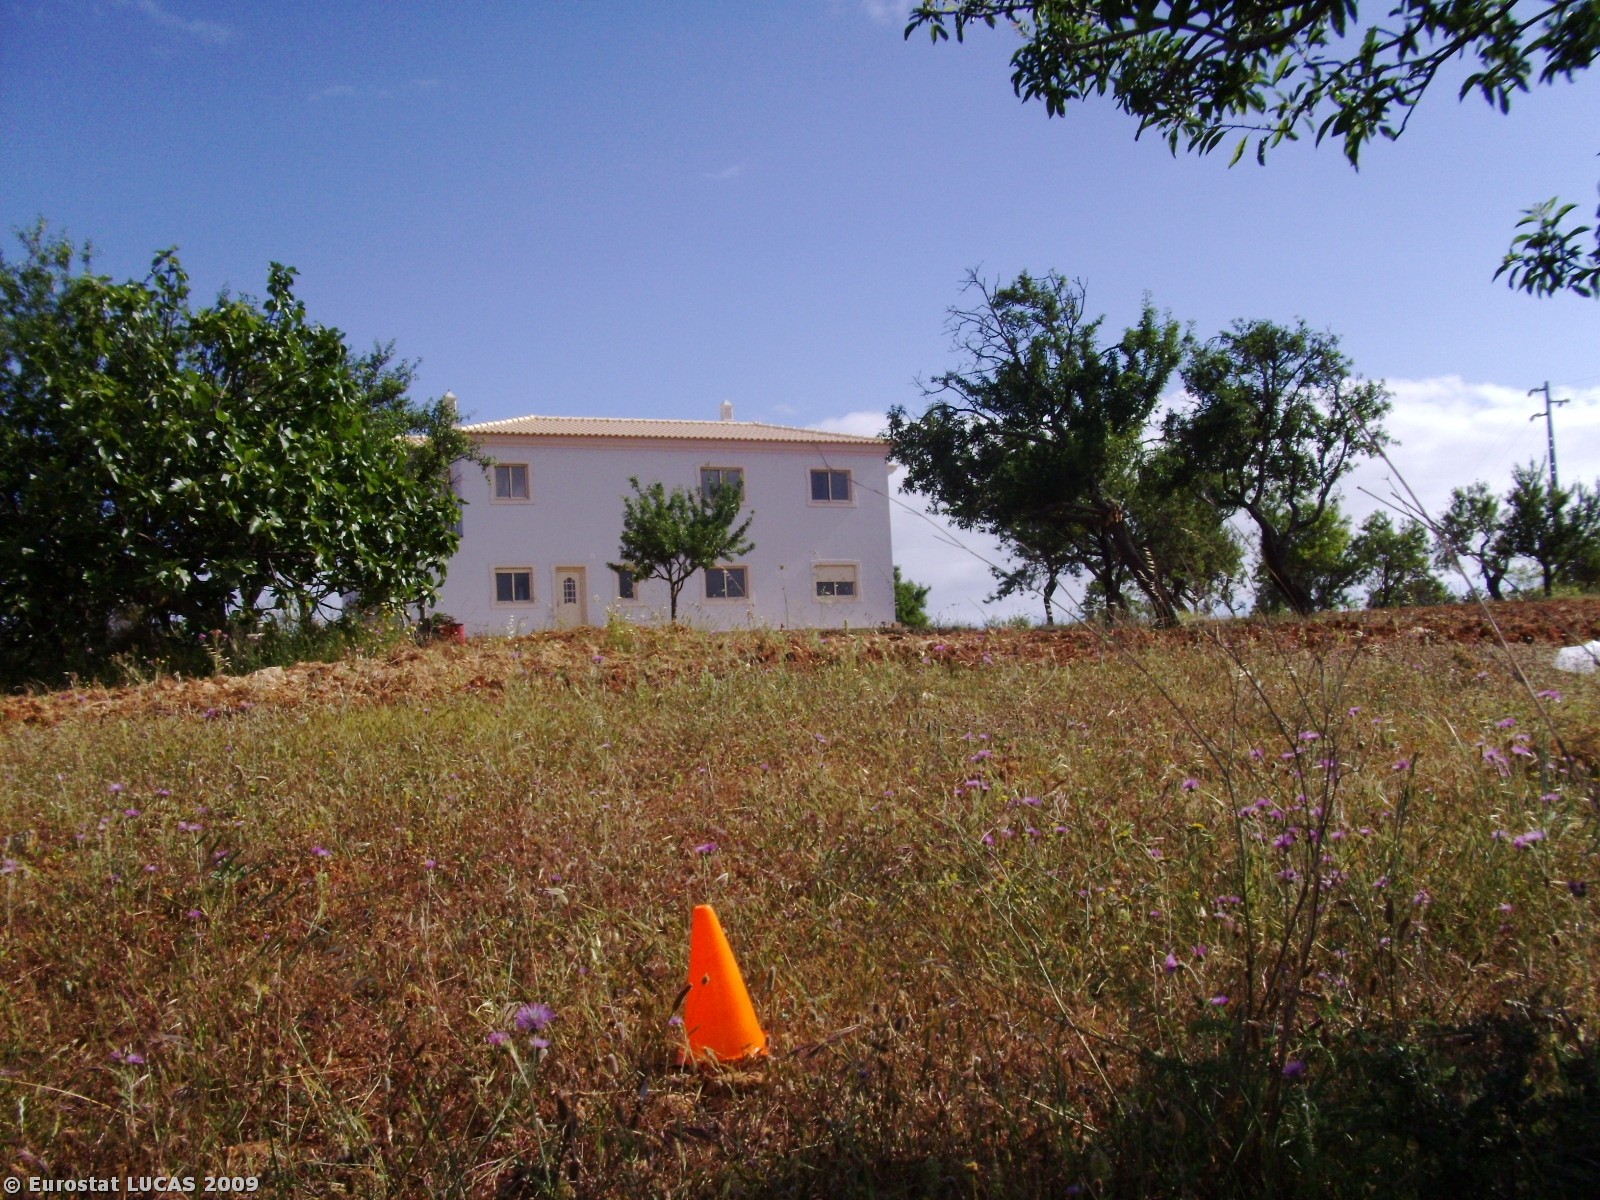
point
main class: Cropland
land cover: Nuts trees
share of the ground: 10 - 25 %
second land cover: Spontaneously vegetated surfaces
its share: 50 - 75 %
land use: Agriculture (excluding fallow land and kitchen gardens)
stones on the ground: 10 - 25 %
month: May
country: PT
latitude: 37.1557
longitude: -8.2258
